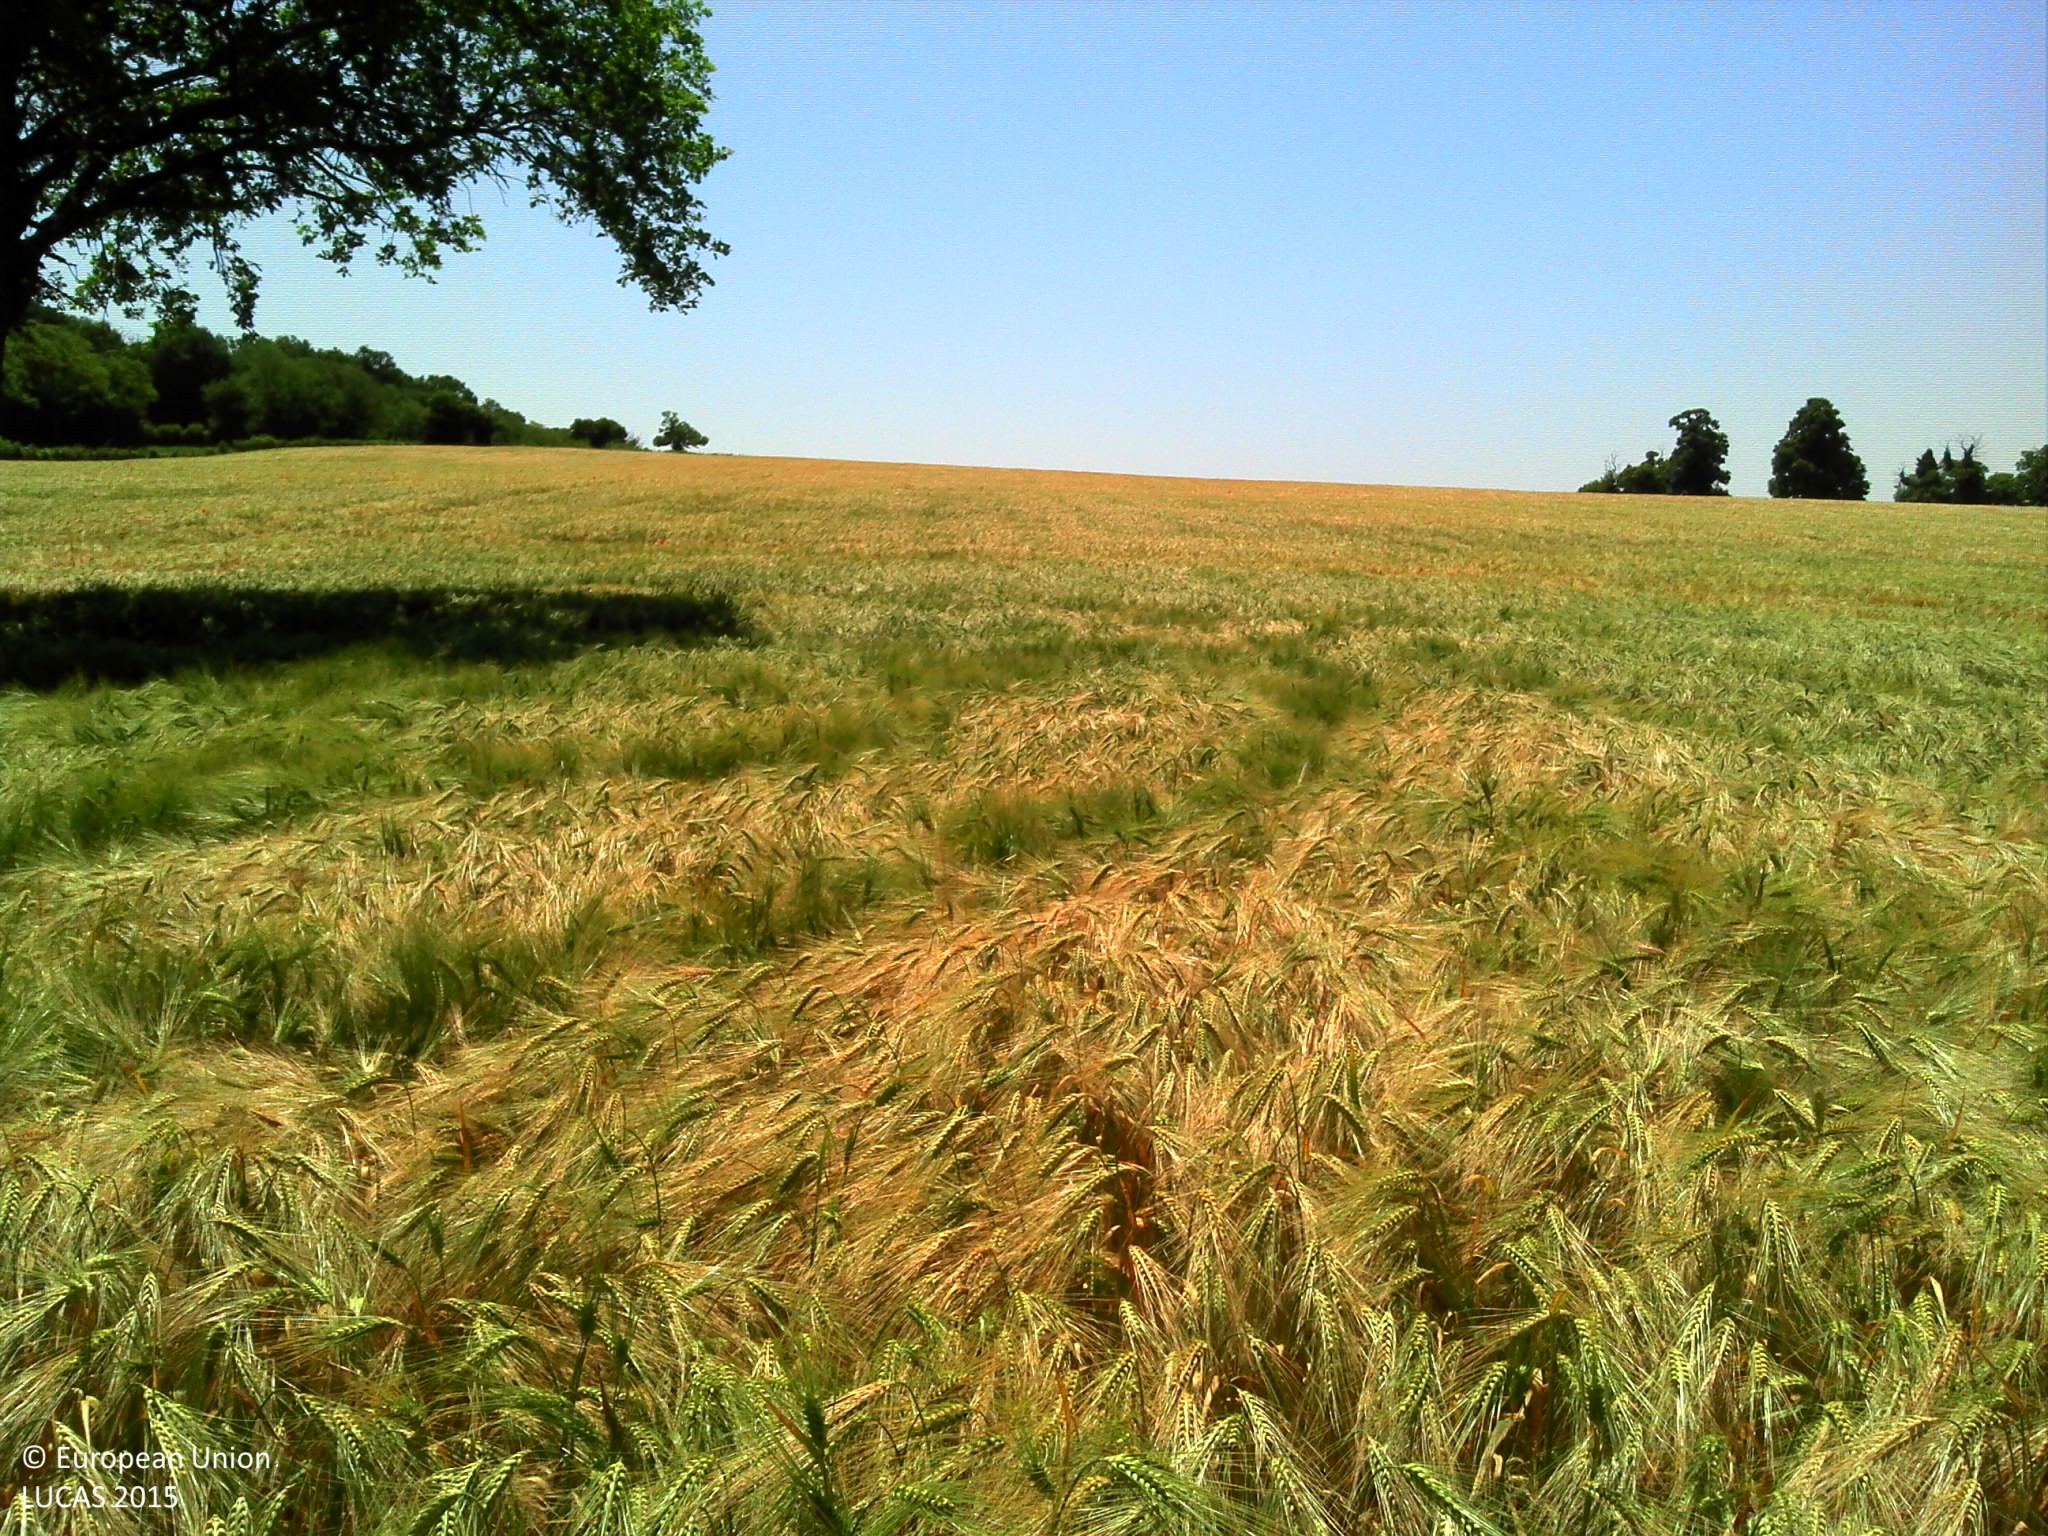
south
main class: Cropland
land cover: Barley
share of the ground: > 75 %
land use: Agriculture (excluding fallow land and kitchen gardens)
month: June
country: FR
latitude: 46.8955
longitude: 2.9473
